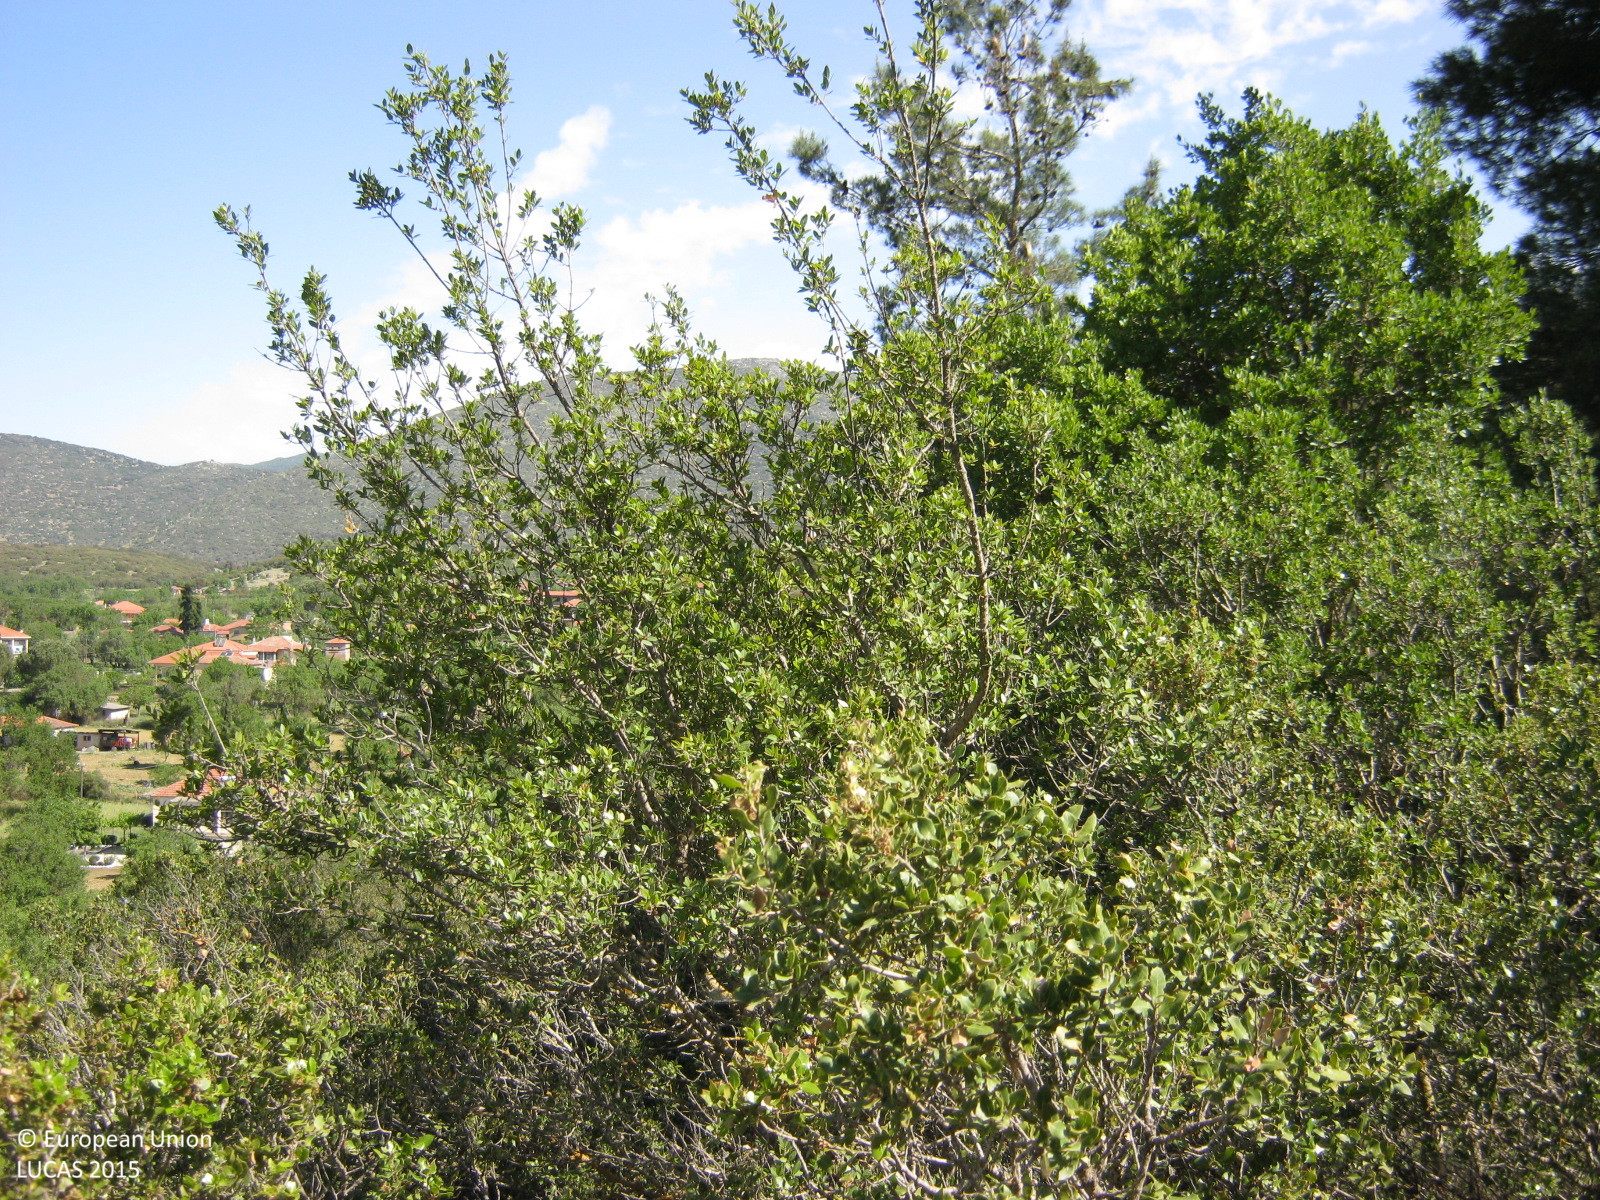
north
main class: Shrubland
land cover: Shrubland with sparse tree cover
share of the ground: 50 - 75 %
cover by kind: shrubs 70 %, herbaceous plants 25 %, coniferous forest trees 5 %
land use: Forestry
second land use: Agriculture (excluding fallow land and kitchen gardens)
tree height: > 5 m
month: May
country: GR
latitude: 37.6684
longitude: 22.3781
